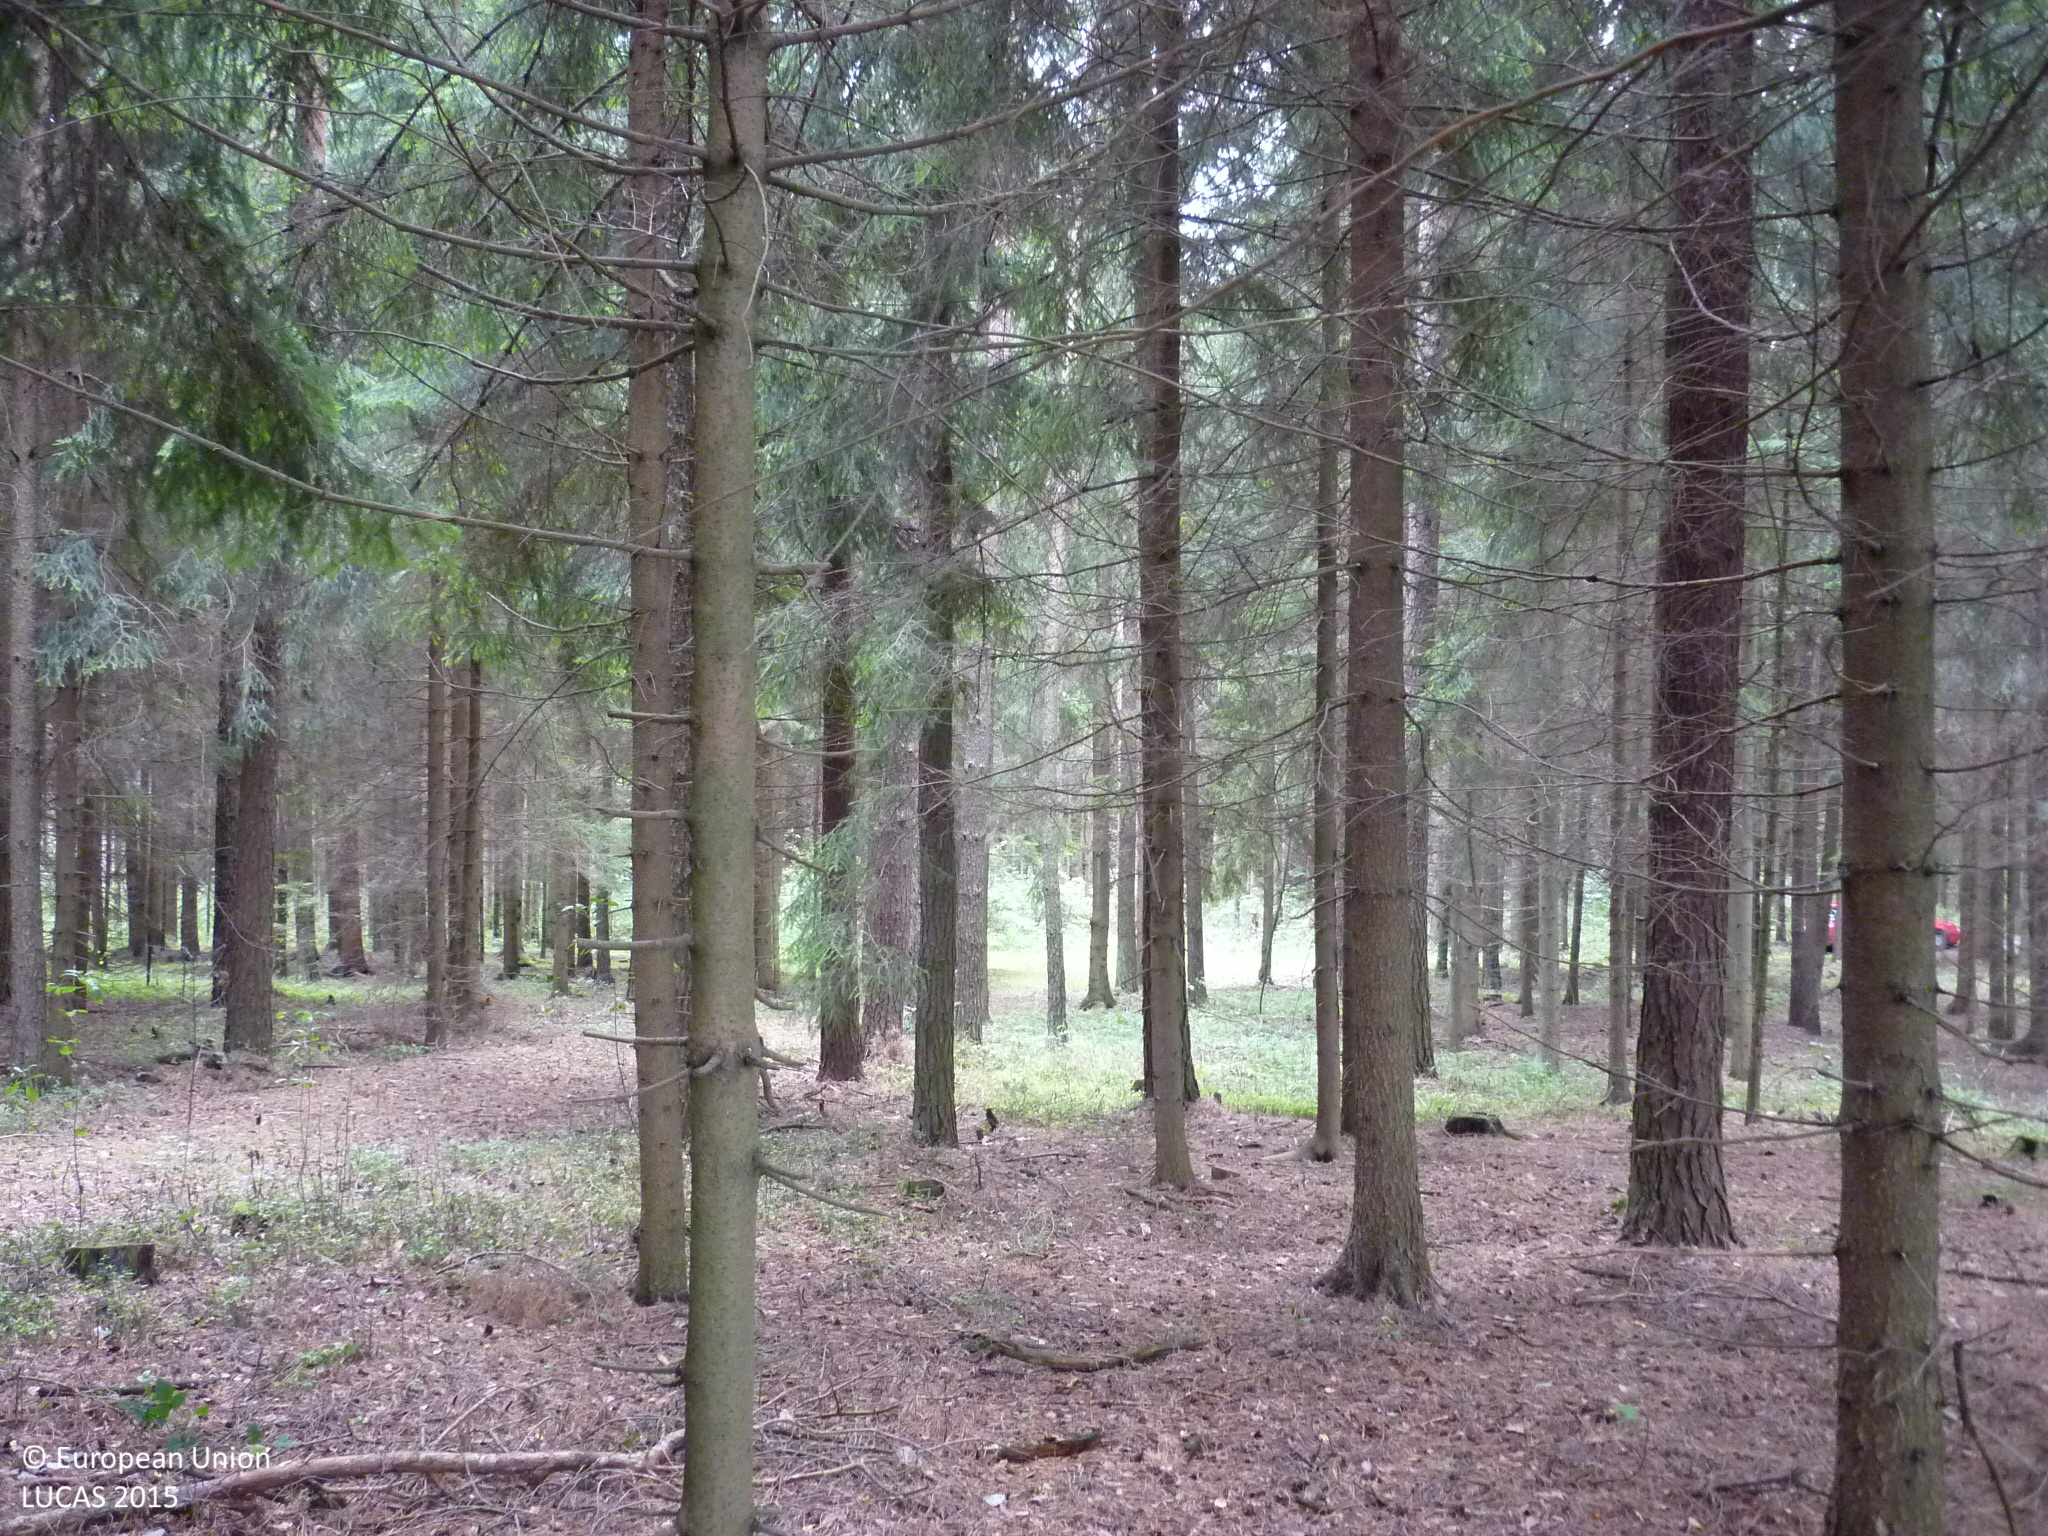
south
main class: Woodland
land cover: Spruce dominated coniferous woodland
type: hemiboreal forest and nemoral coniferous forest and mixed broadleaved-coniferous forest
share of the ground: > 75 %
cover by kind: coniferous forest trees 95 %, unconsolidated bare surface 5 %
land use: Forestry
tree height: > 5 m
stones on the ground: < 10 %
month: September
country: AT
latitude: 48.8992
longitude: 15.0904
